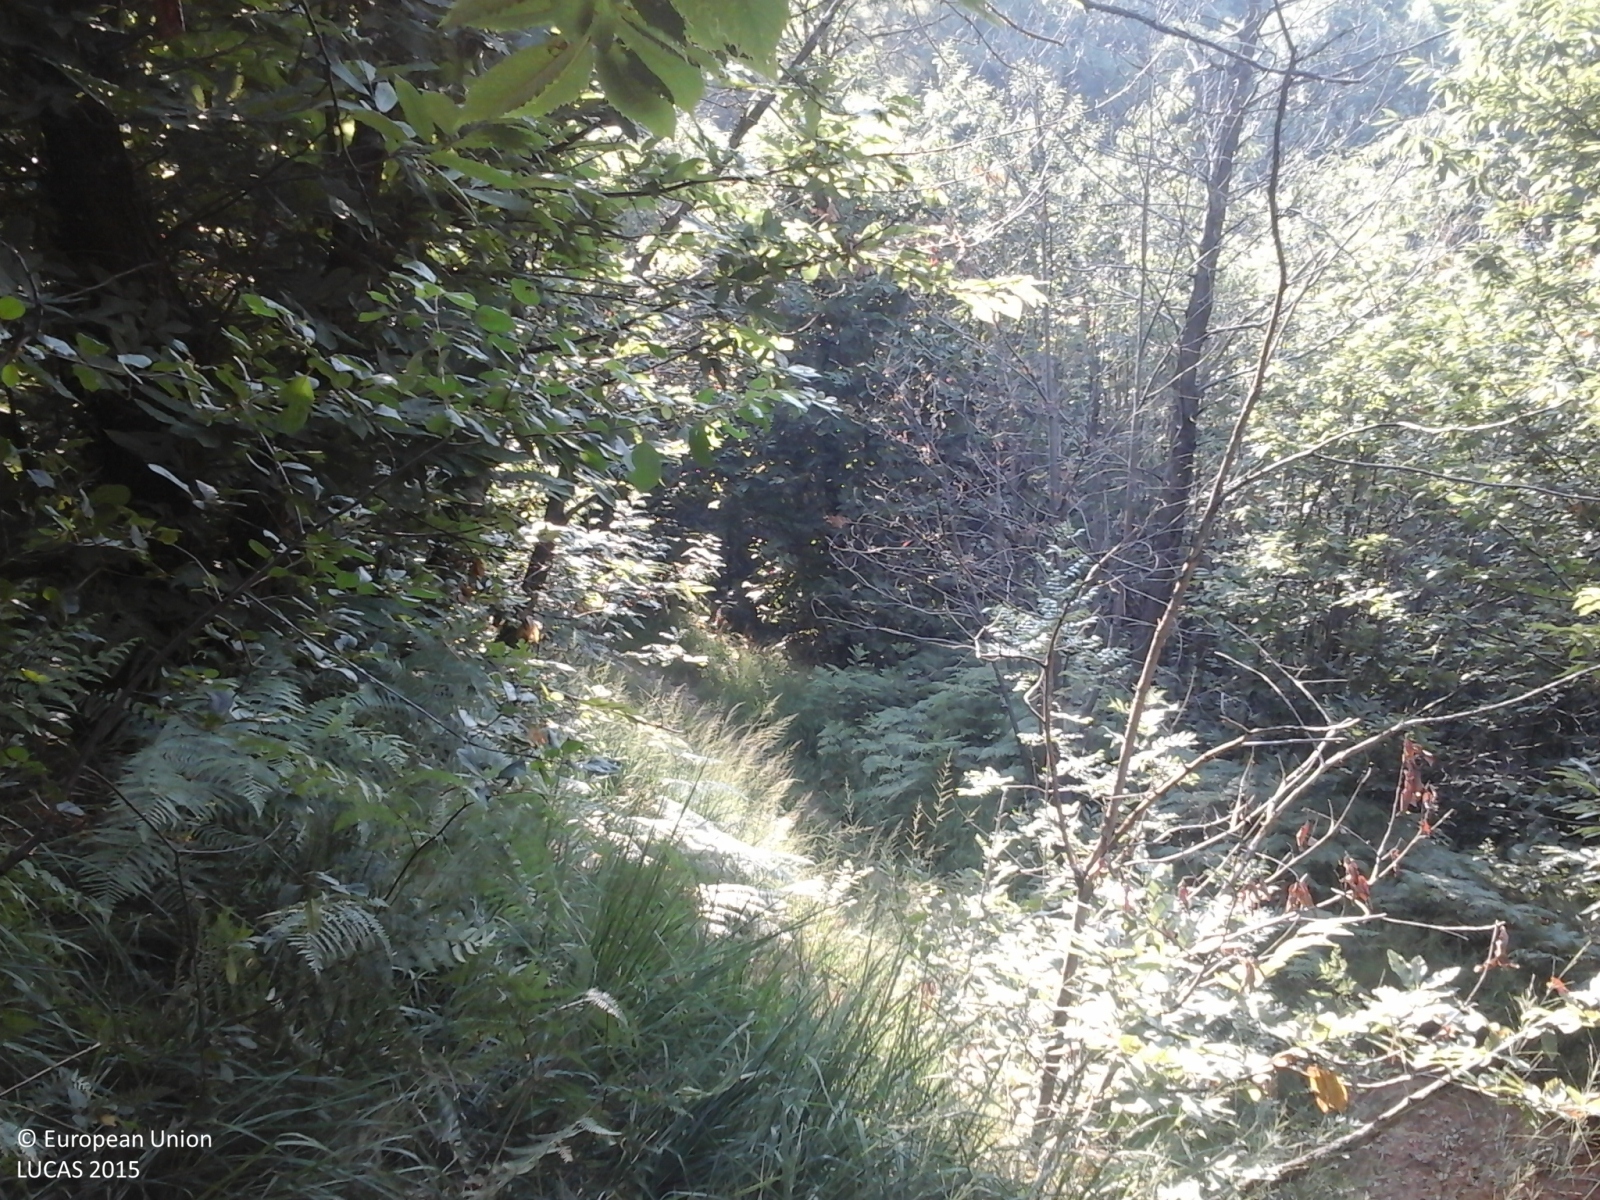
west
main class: Woodland
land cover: Broadleaved woodland
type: thermophilous deciduous forest
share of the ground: > 75 %
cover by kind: broadleaved forest trees 100 %
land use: Semi-natural and natural areas not in use
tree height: > 5 m
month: July
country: IT
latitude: 44.8563
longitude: 7.2842
